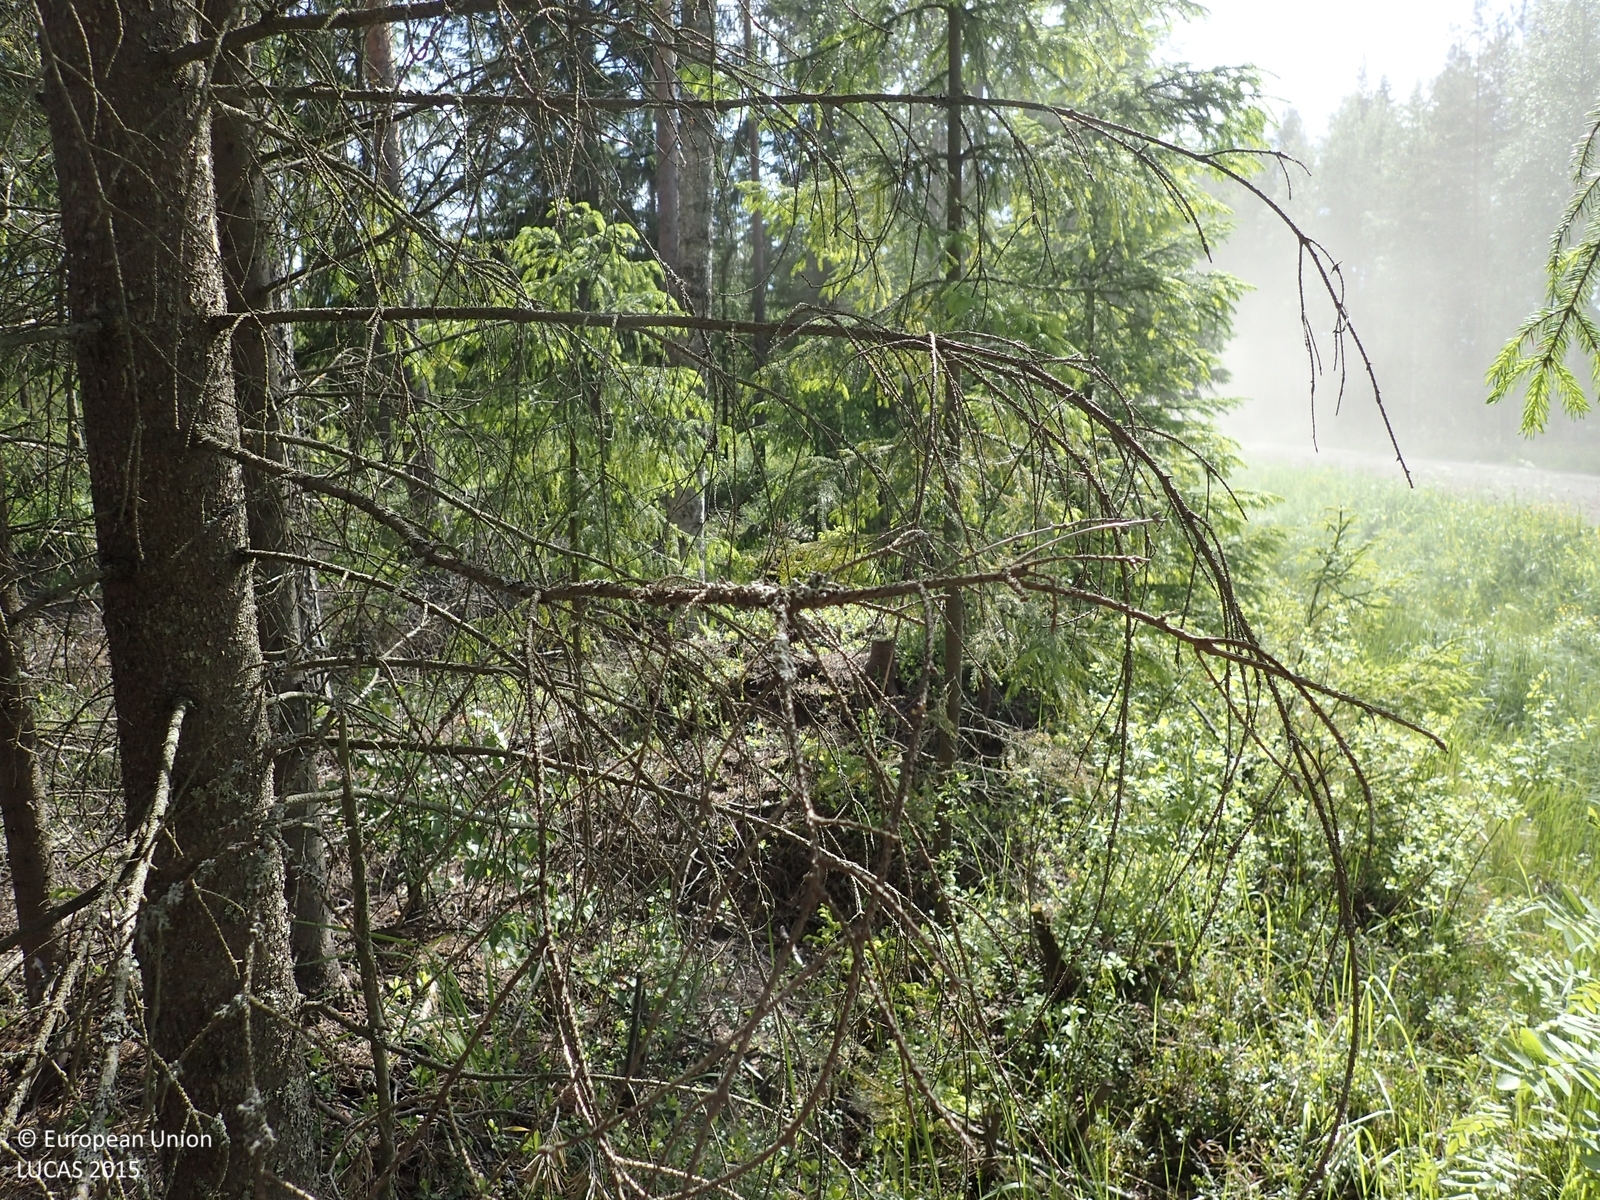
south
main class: Woodland
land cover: Pine dominated coniferous woodland
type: boreal forest
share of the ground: 25 - 50 %
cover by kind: coniferous forest trees 35 %, shrubs 30 %, herbaceous plants 20 %, lichens and mosses 10 %, broadleaved forest trees 5 %
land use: Forestry
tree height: > 5 m
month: June
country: FI
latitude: 62.4534
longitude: 21.6162
